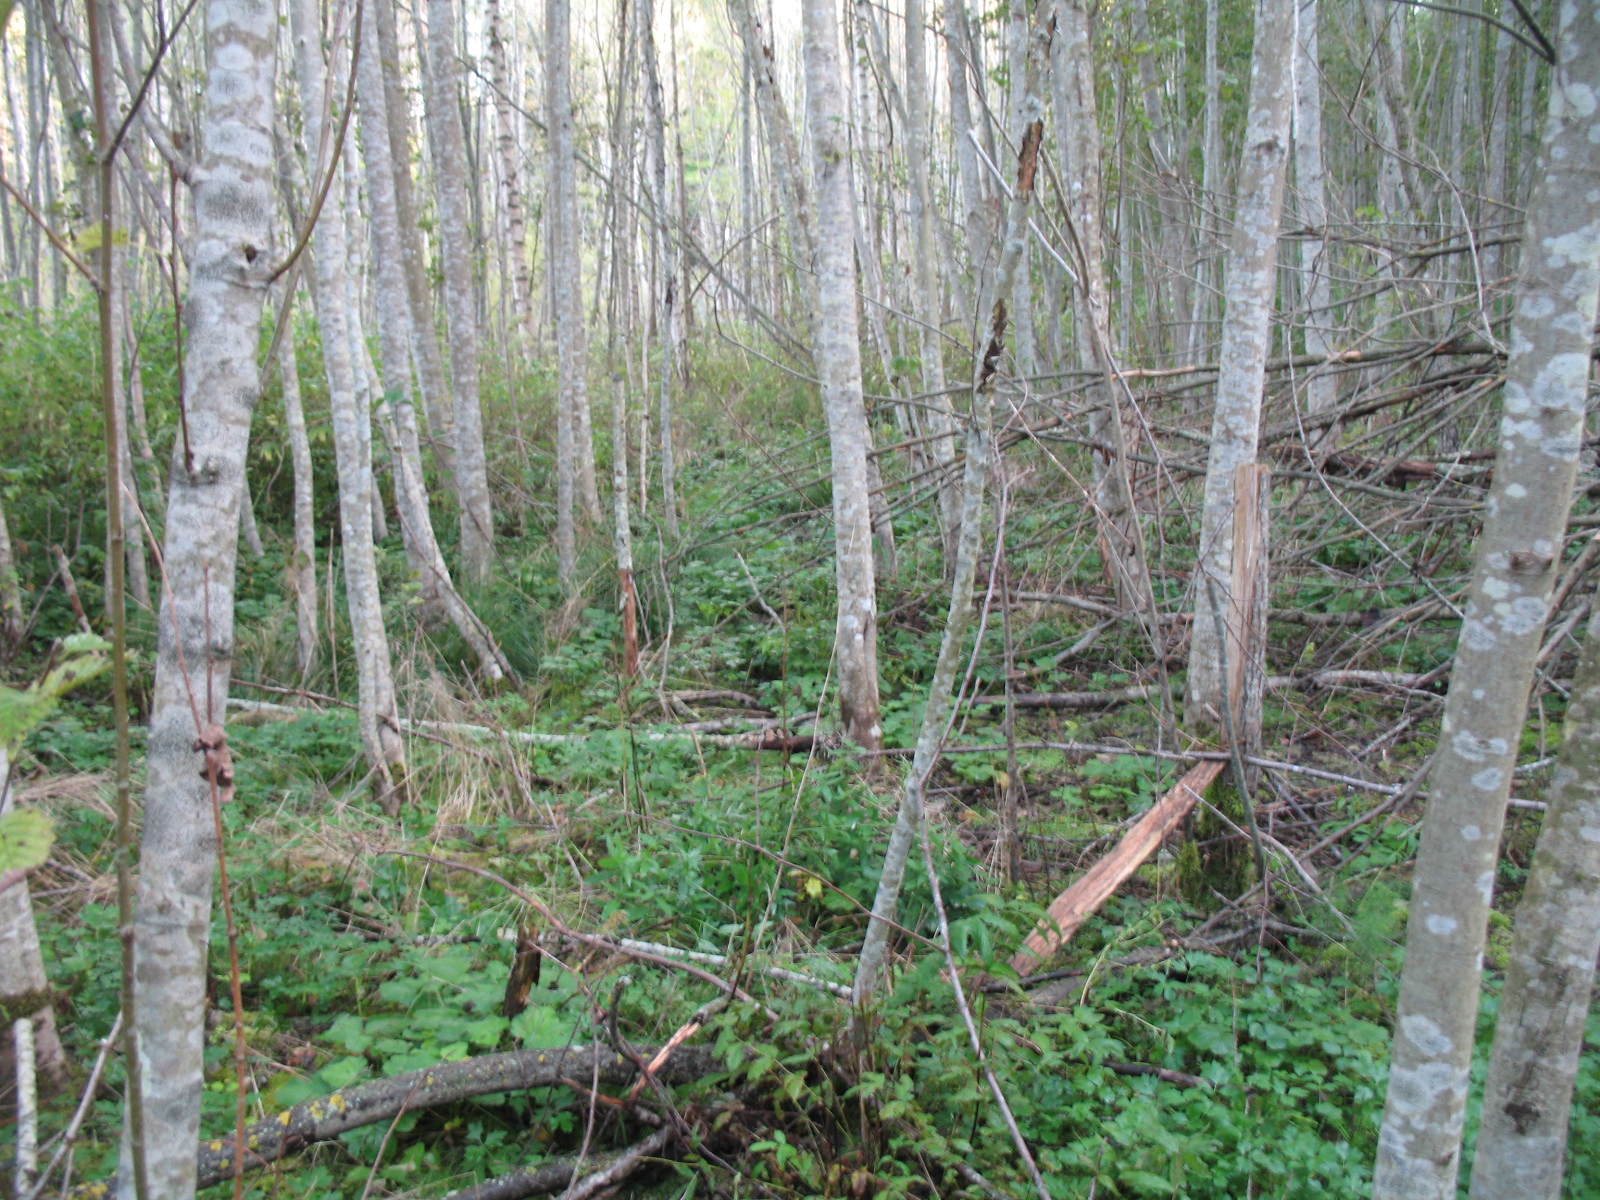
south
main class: Woodland
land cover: Broadleaved woodland
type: floodplain forest
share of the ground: > 75 %
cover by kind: broadleaved forest trees 80 %, herbaceous plants 10 %, lichens and mosses 5 %
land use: Forestry
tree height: > 5 m
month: September
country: LV
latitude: 56.1611
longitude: 25.8959
